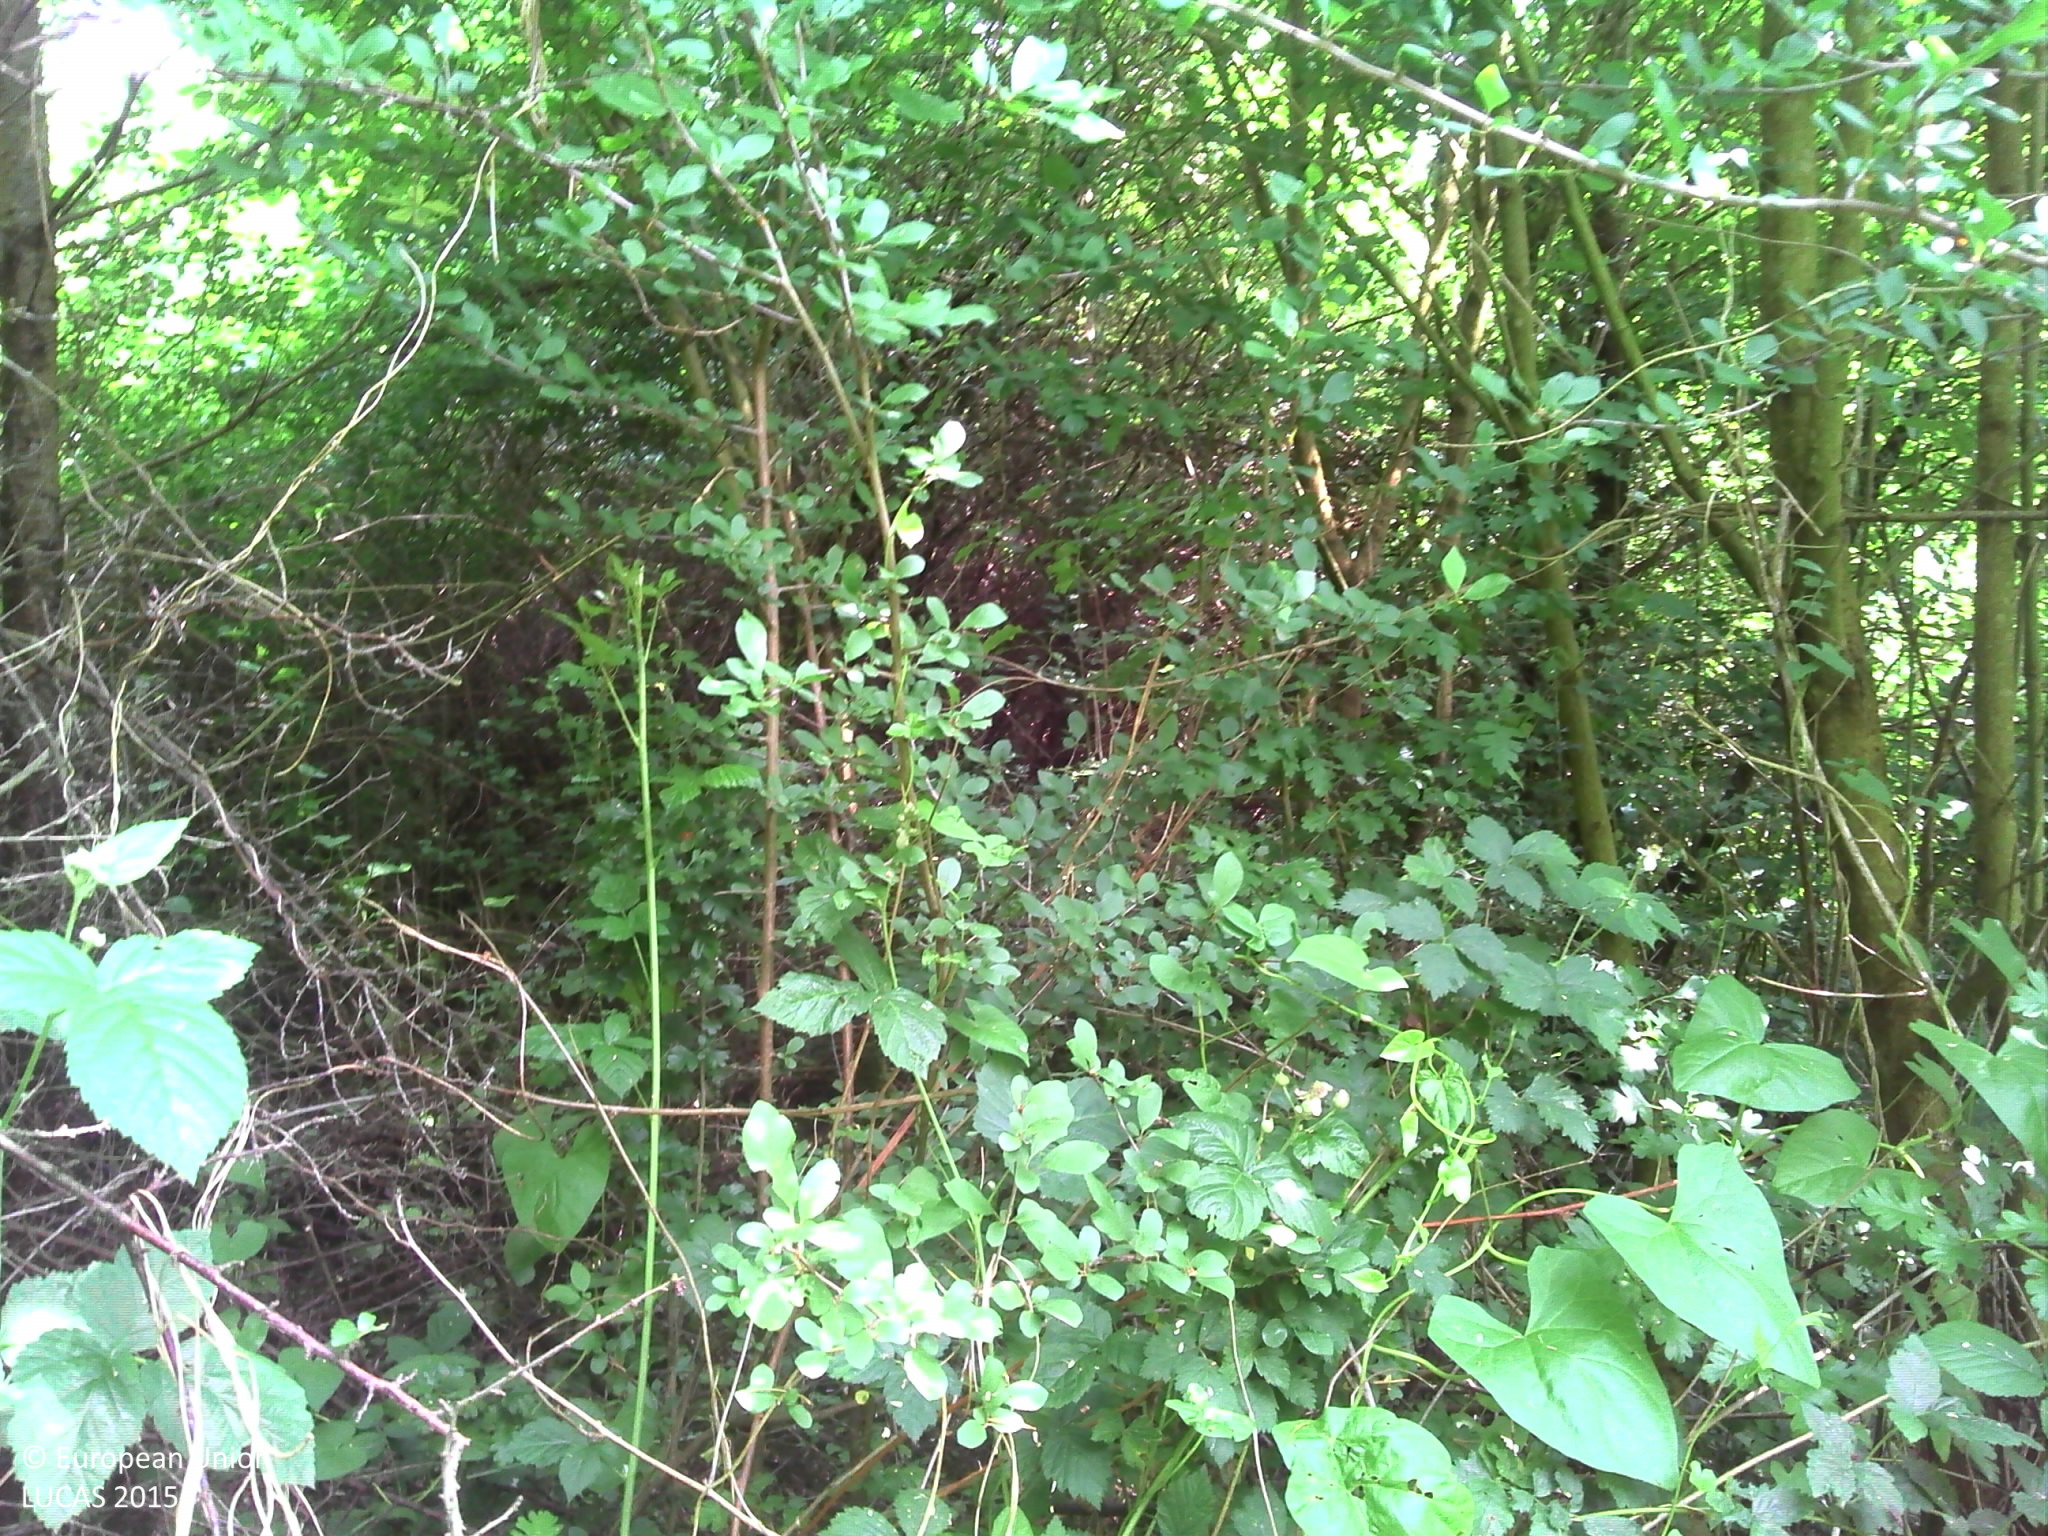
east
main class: Woodland
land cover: Broadleaved woodland
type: mesophytic deciduous forest
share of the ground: 50 - 75 %
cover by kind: broadleaved forest trees 65 %, shrubs 20 %, herbaceous plants 10 %, coniferous forest trees 5 %
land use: Forestry
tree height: > 5 m
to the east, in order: Broadleaved woodland; Grass margins; Paved roads, cycling and walking lanes; Grass margins; Fences; Broadleaved woodland; Fences; Grass margins; Paved roads, cycling and walking lanes; Grass margins; Broadleaved woodland
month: June
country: BE
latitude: 50.3482
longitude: 5.5153
